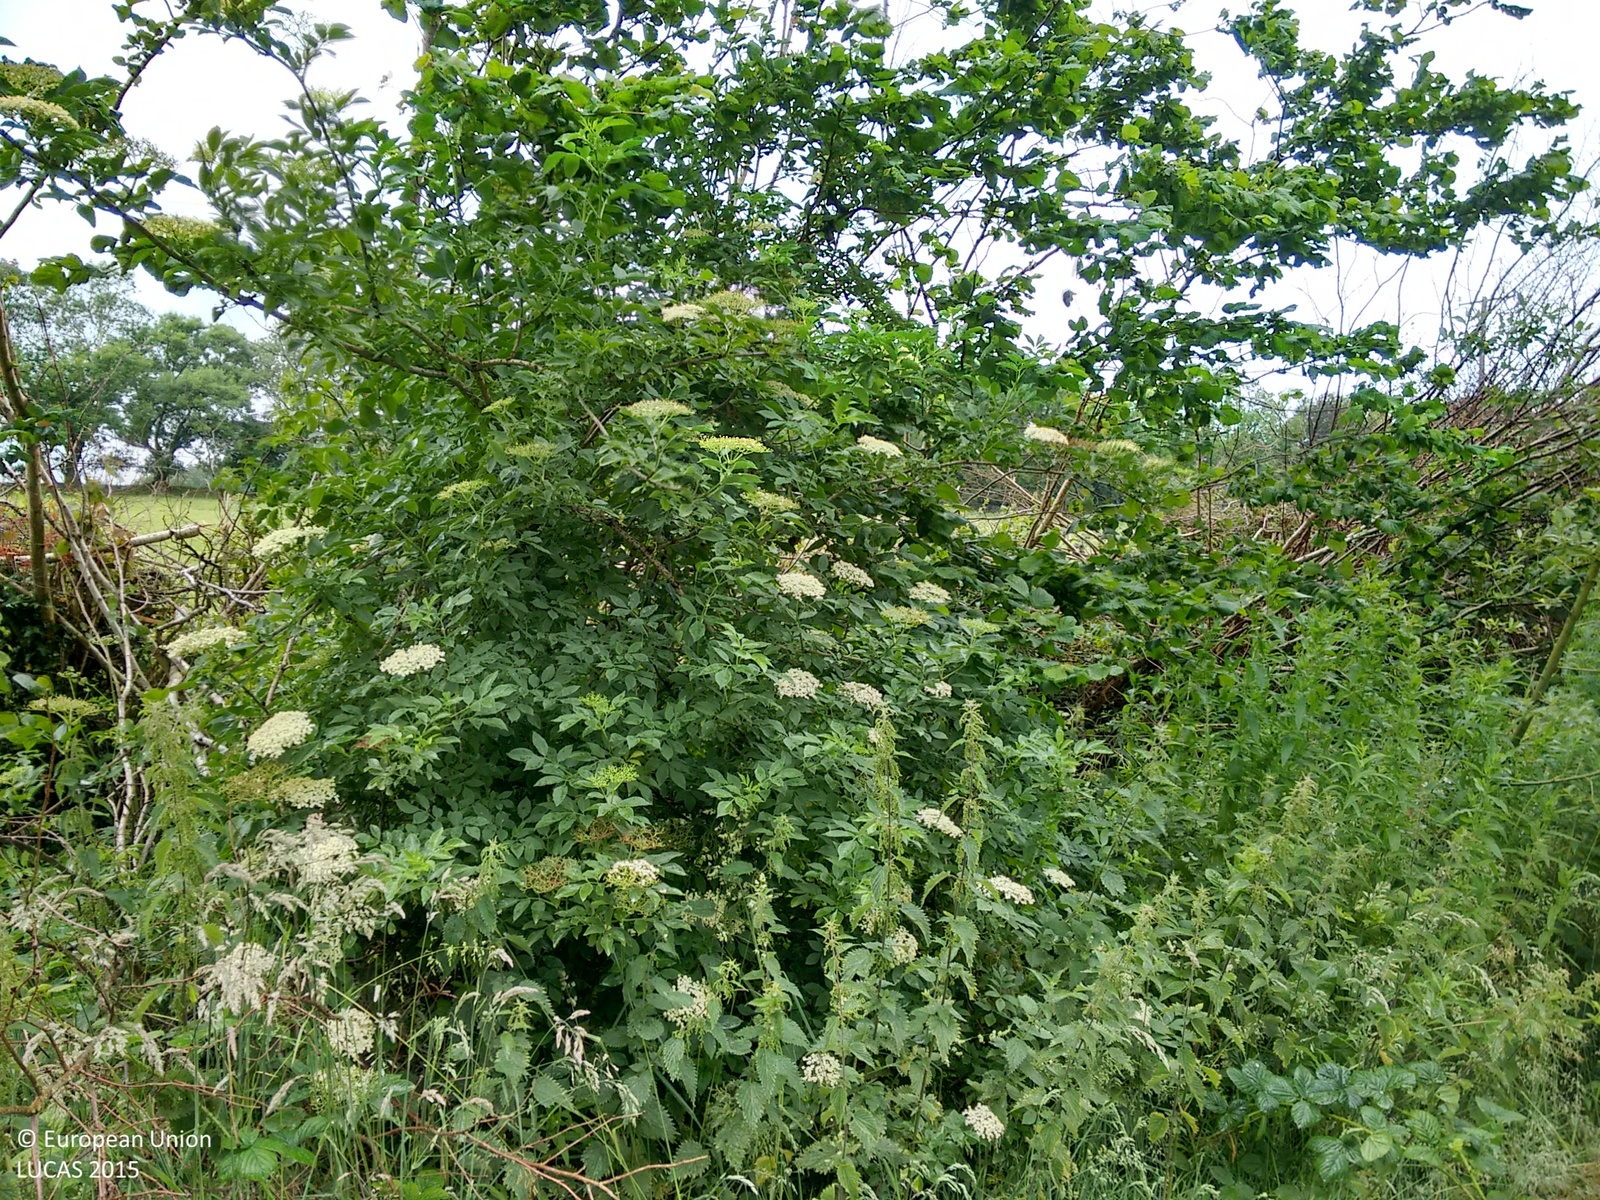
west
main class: Grassland
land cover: Grassland without tree/shrub cover
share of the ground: > 75 %
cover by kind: herbaceous plants 100 %
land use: Agriculture (excluding fallow land and kitchen gardens)
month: July
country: IE
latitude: 53.5839
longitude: -8.1402
